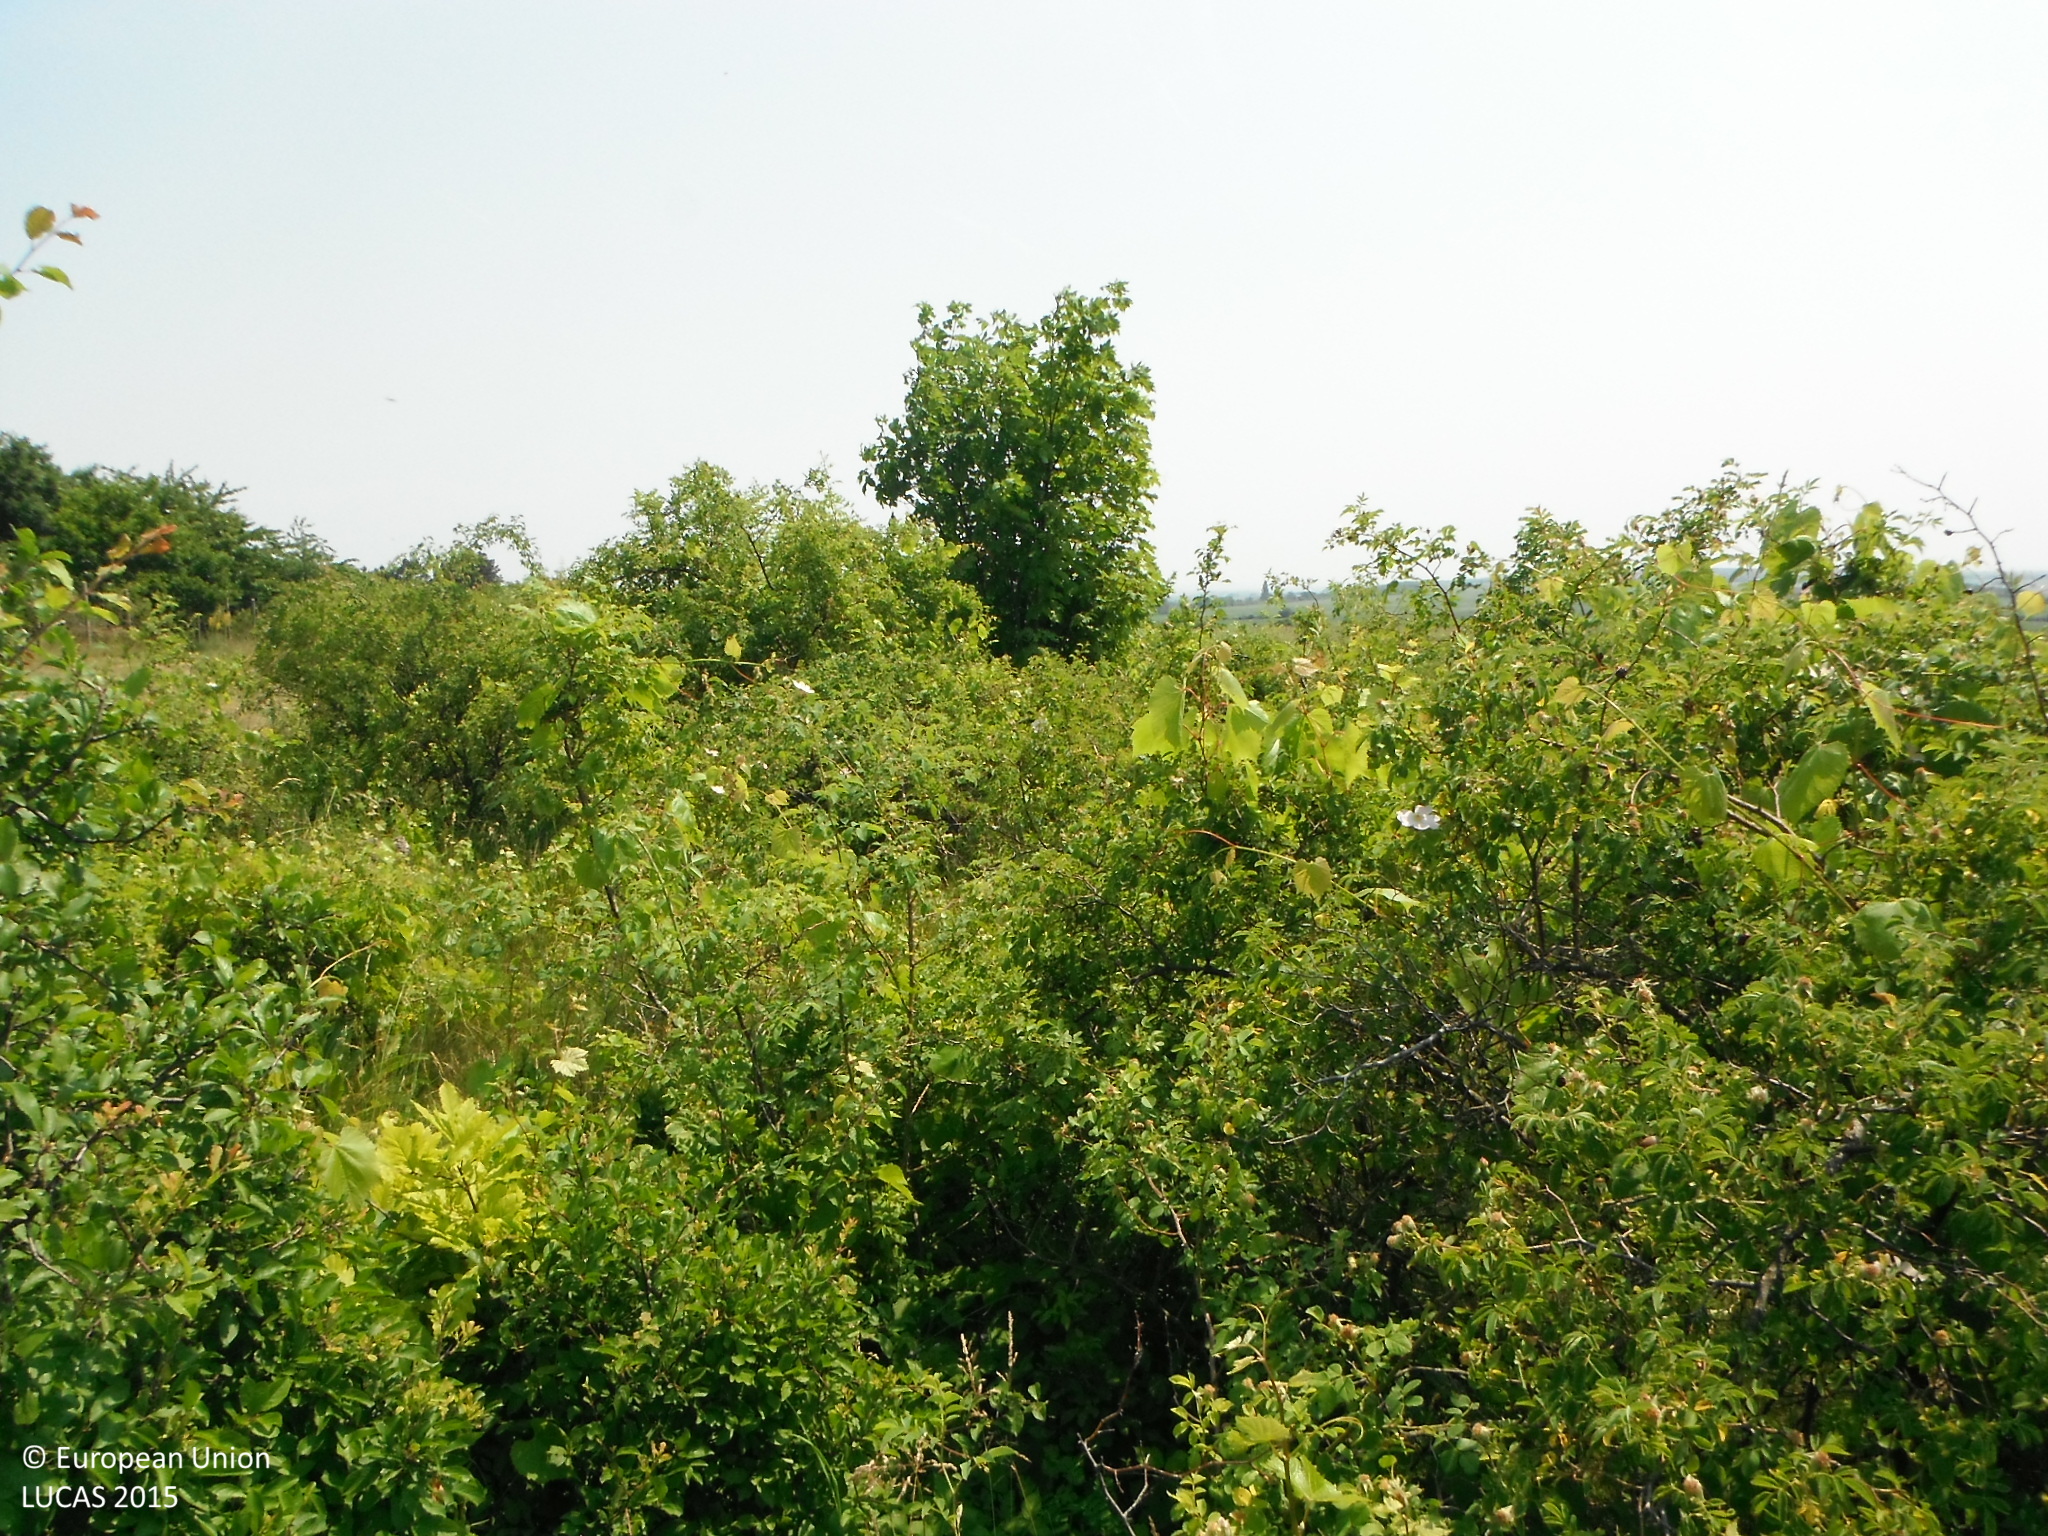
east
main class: Cropland
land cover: Vineyards
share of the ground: 50 - 75 %
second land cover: Shrubland without tree cover
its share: 50 - 75 %
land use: Abandoned areas
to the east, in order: Vineyards; Shrubland without tree cover; Grassland without tree/shrub cover; Fences; Broadleaved woodland; Grassland with sparse tree/shrub cover; Shrubland with sparse tree cover; Grassland with sparse tree/shrub cover
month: June
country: SK
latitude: 48.4781
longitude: 17.4371
